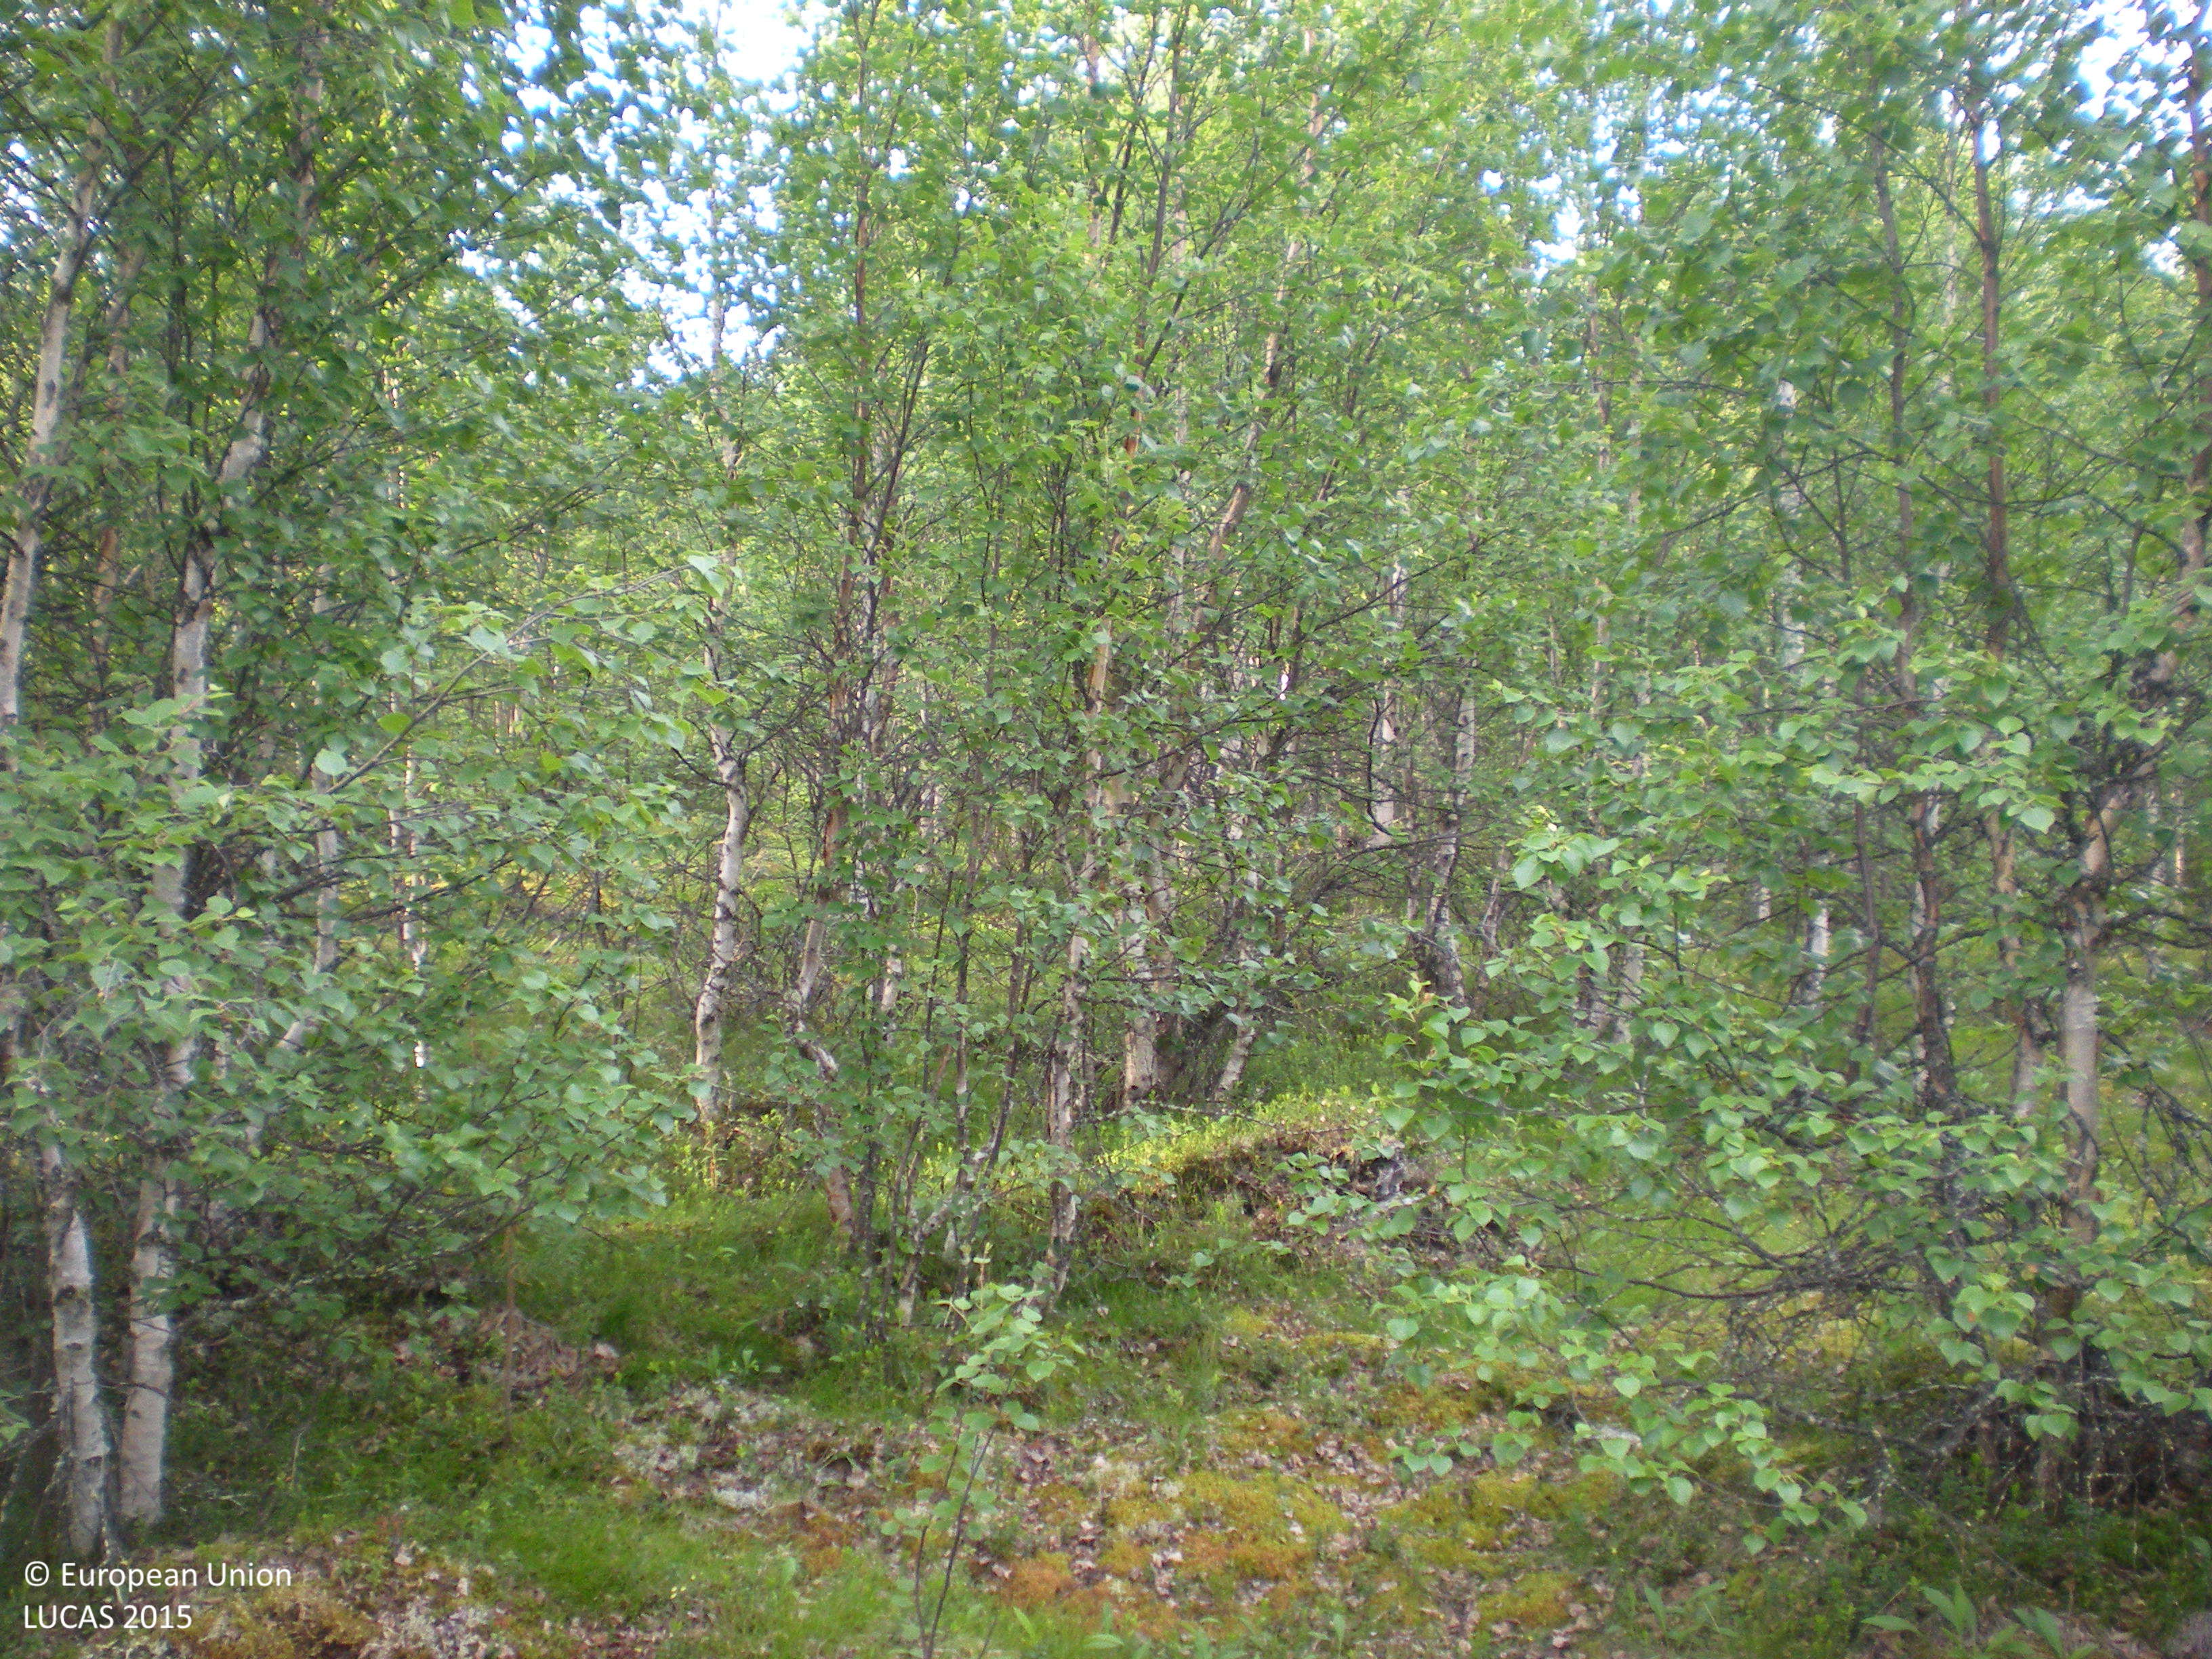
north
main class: Woodland
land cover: Broadleaved woodland
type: boreal forest
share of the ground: 50 - 75 %
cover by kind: broadleaved forest trees 70 %, lichens and mosses 15 %, herbaceous plants 10 %, shrubs 5 %
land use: Forestry
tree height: > 5 m
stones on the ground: > 50 %
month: July
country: SE
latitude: 65.6097
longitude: 17.7066
